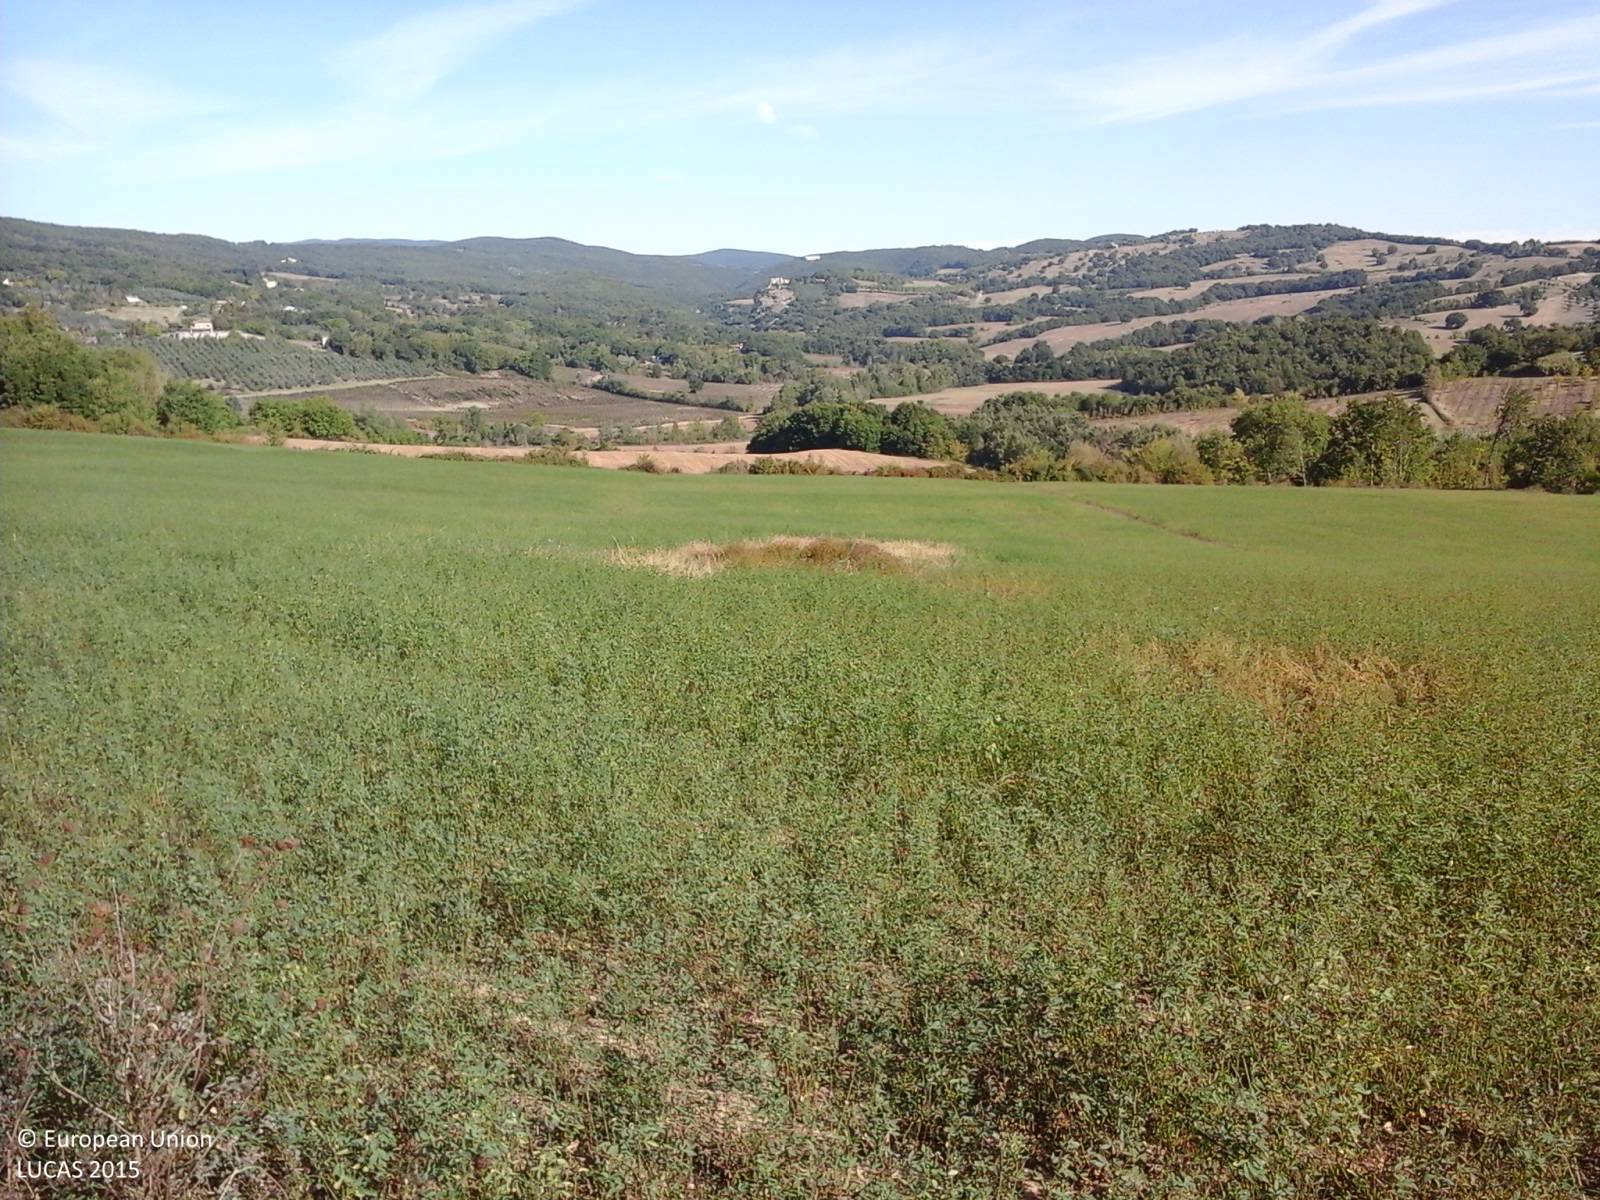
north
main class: Cropland
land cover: Lucerne
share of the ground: > 75 %
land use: Agriculture (excluding fallow land and kitchen gardens)
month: September
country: IT
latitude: 42.4813
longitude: 12.3885
